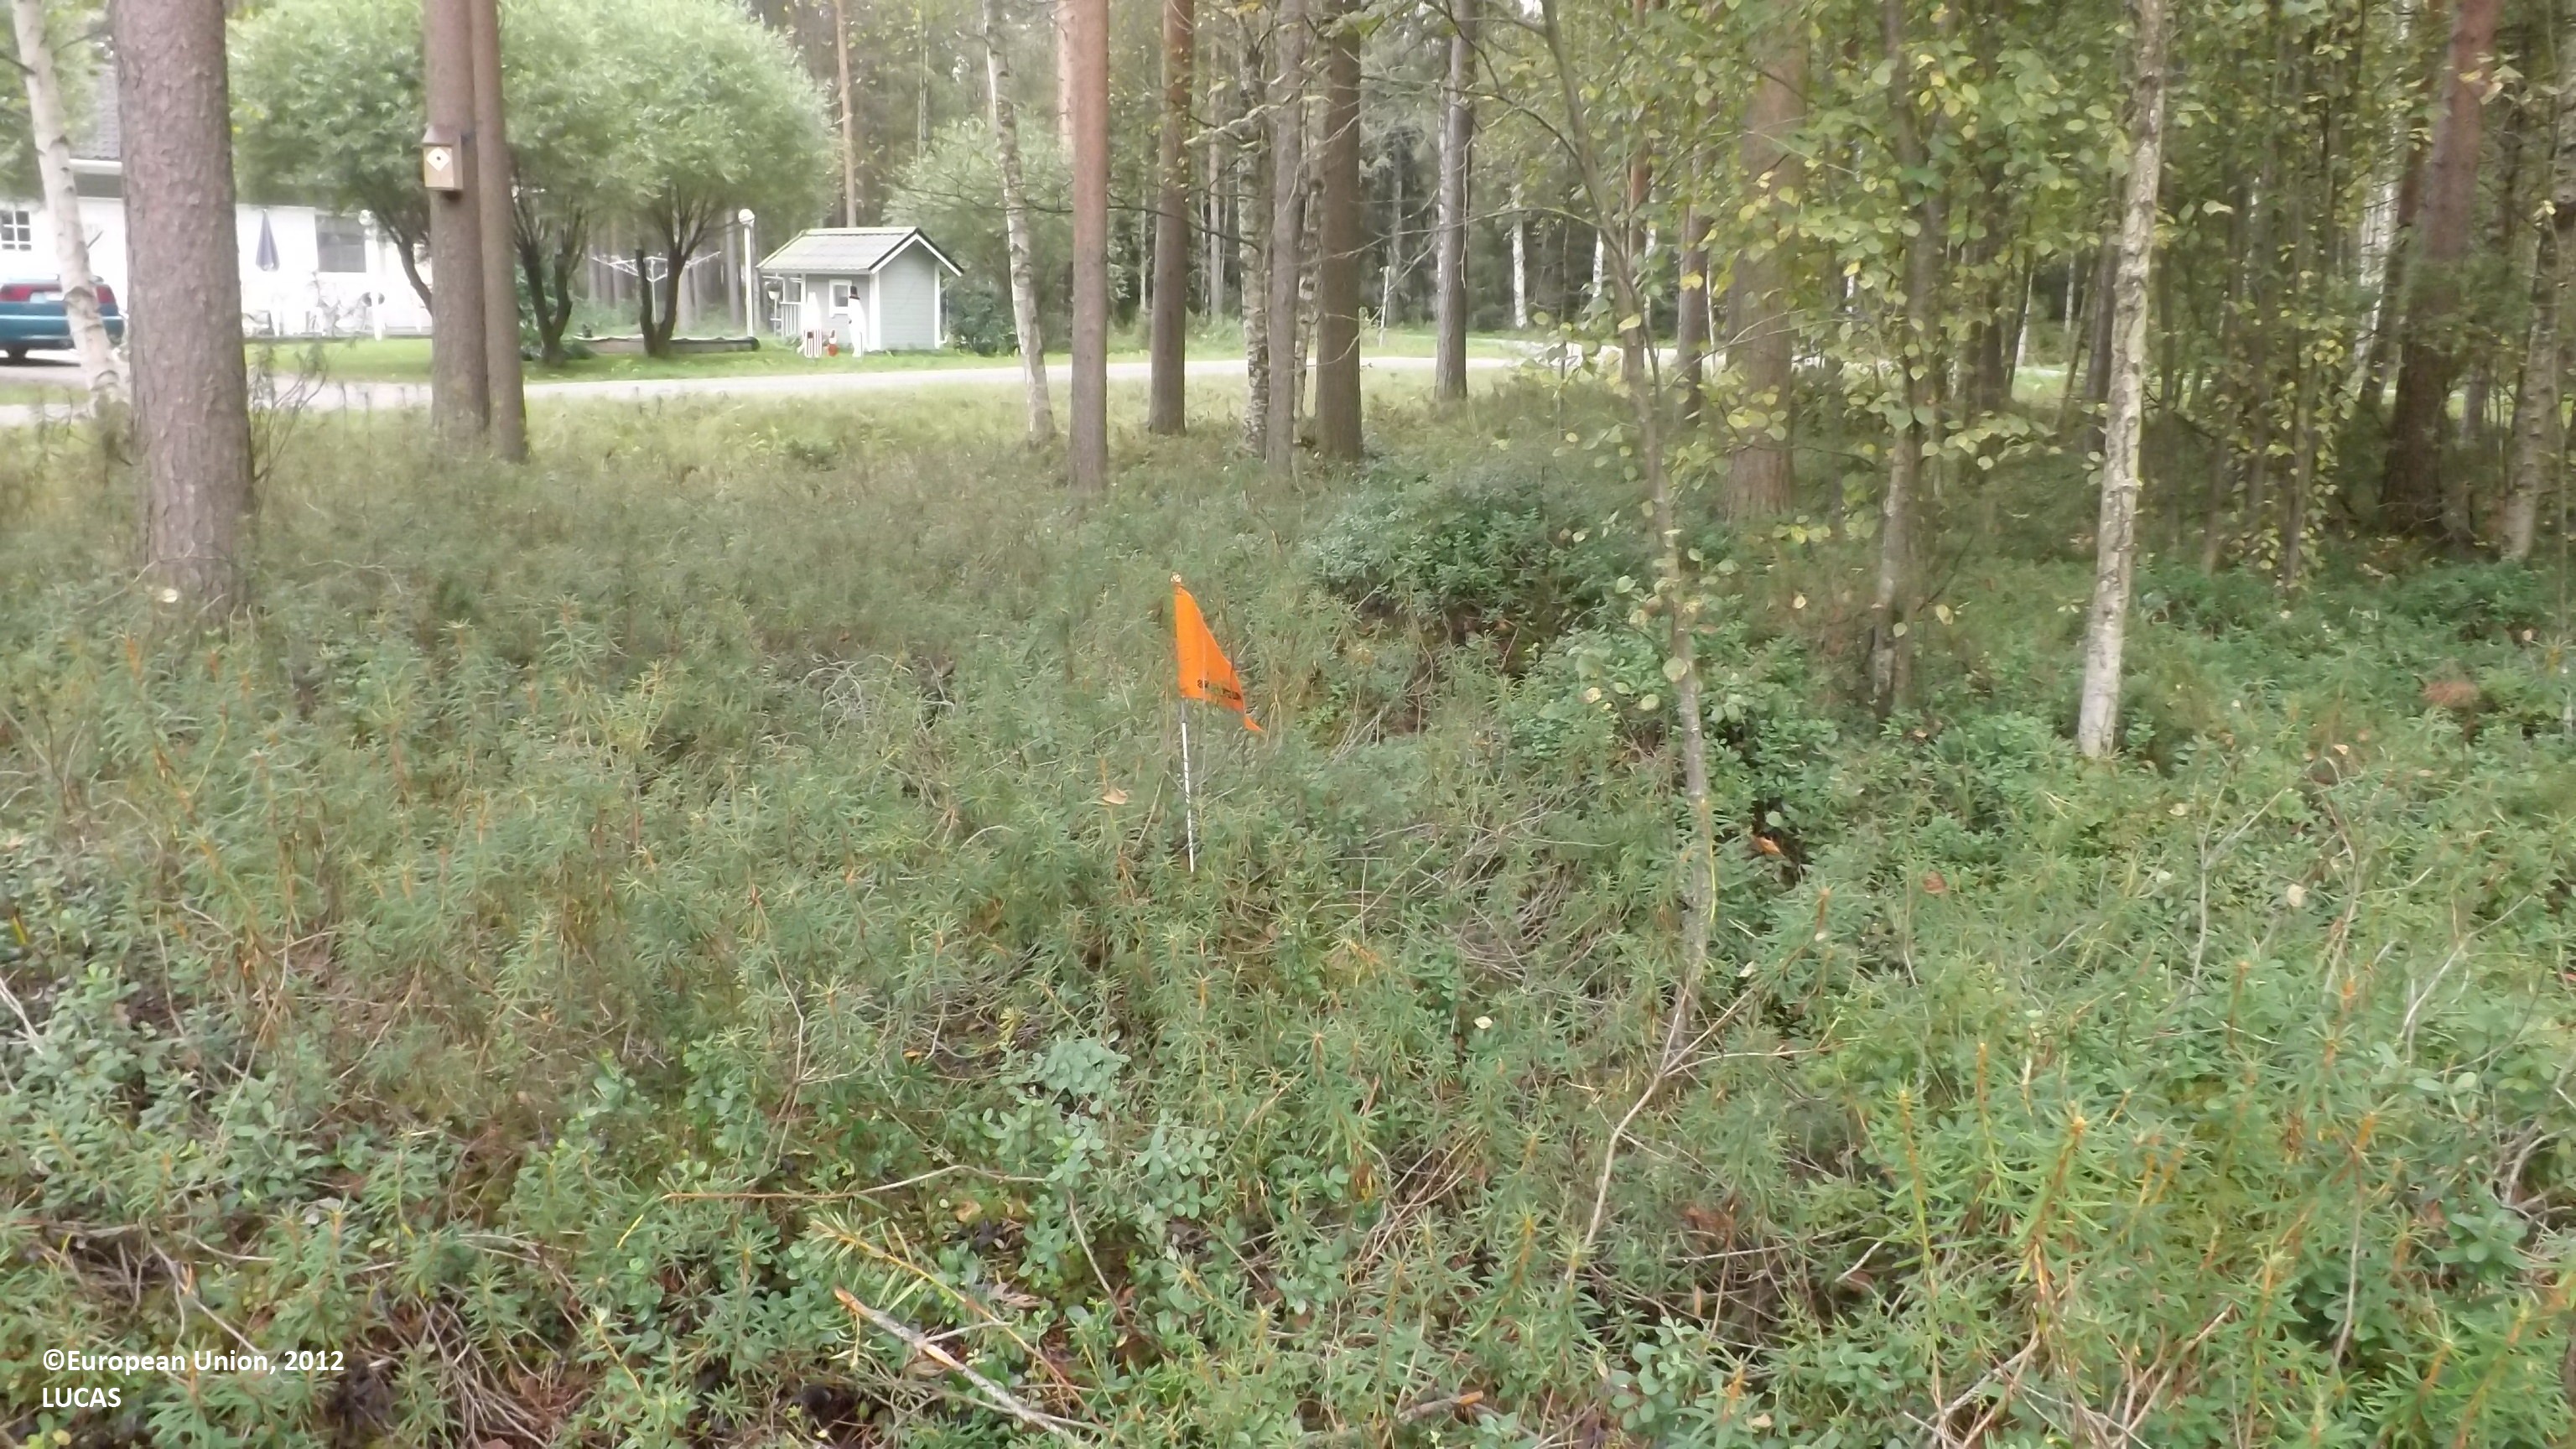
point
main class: Woodland
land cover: Pine dominated coniferous woodland
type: boreal forest
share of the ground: 50 - 75 %
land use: Forestry
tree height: > 5 m
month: August
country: FI
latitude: 63.8970
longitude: 23.8550
